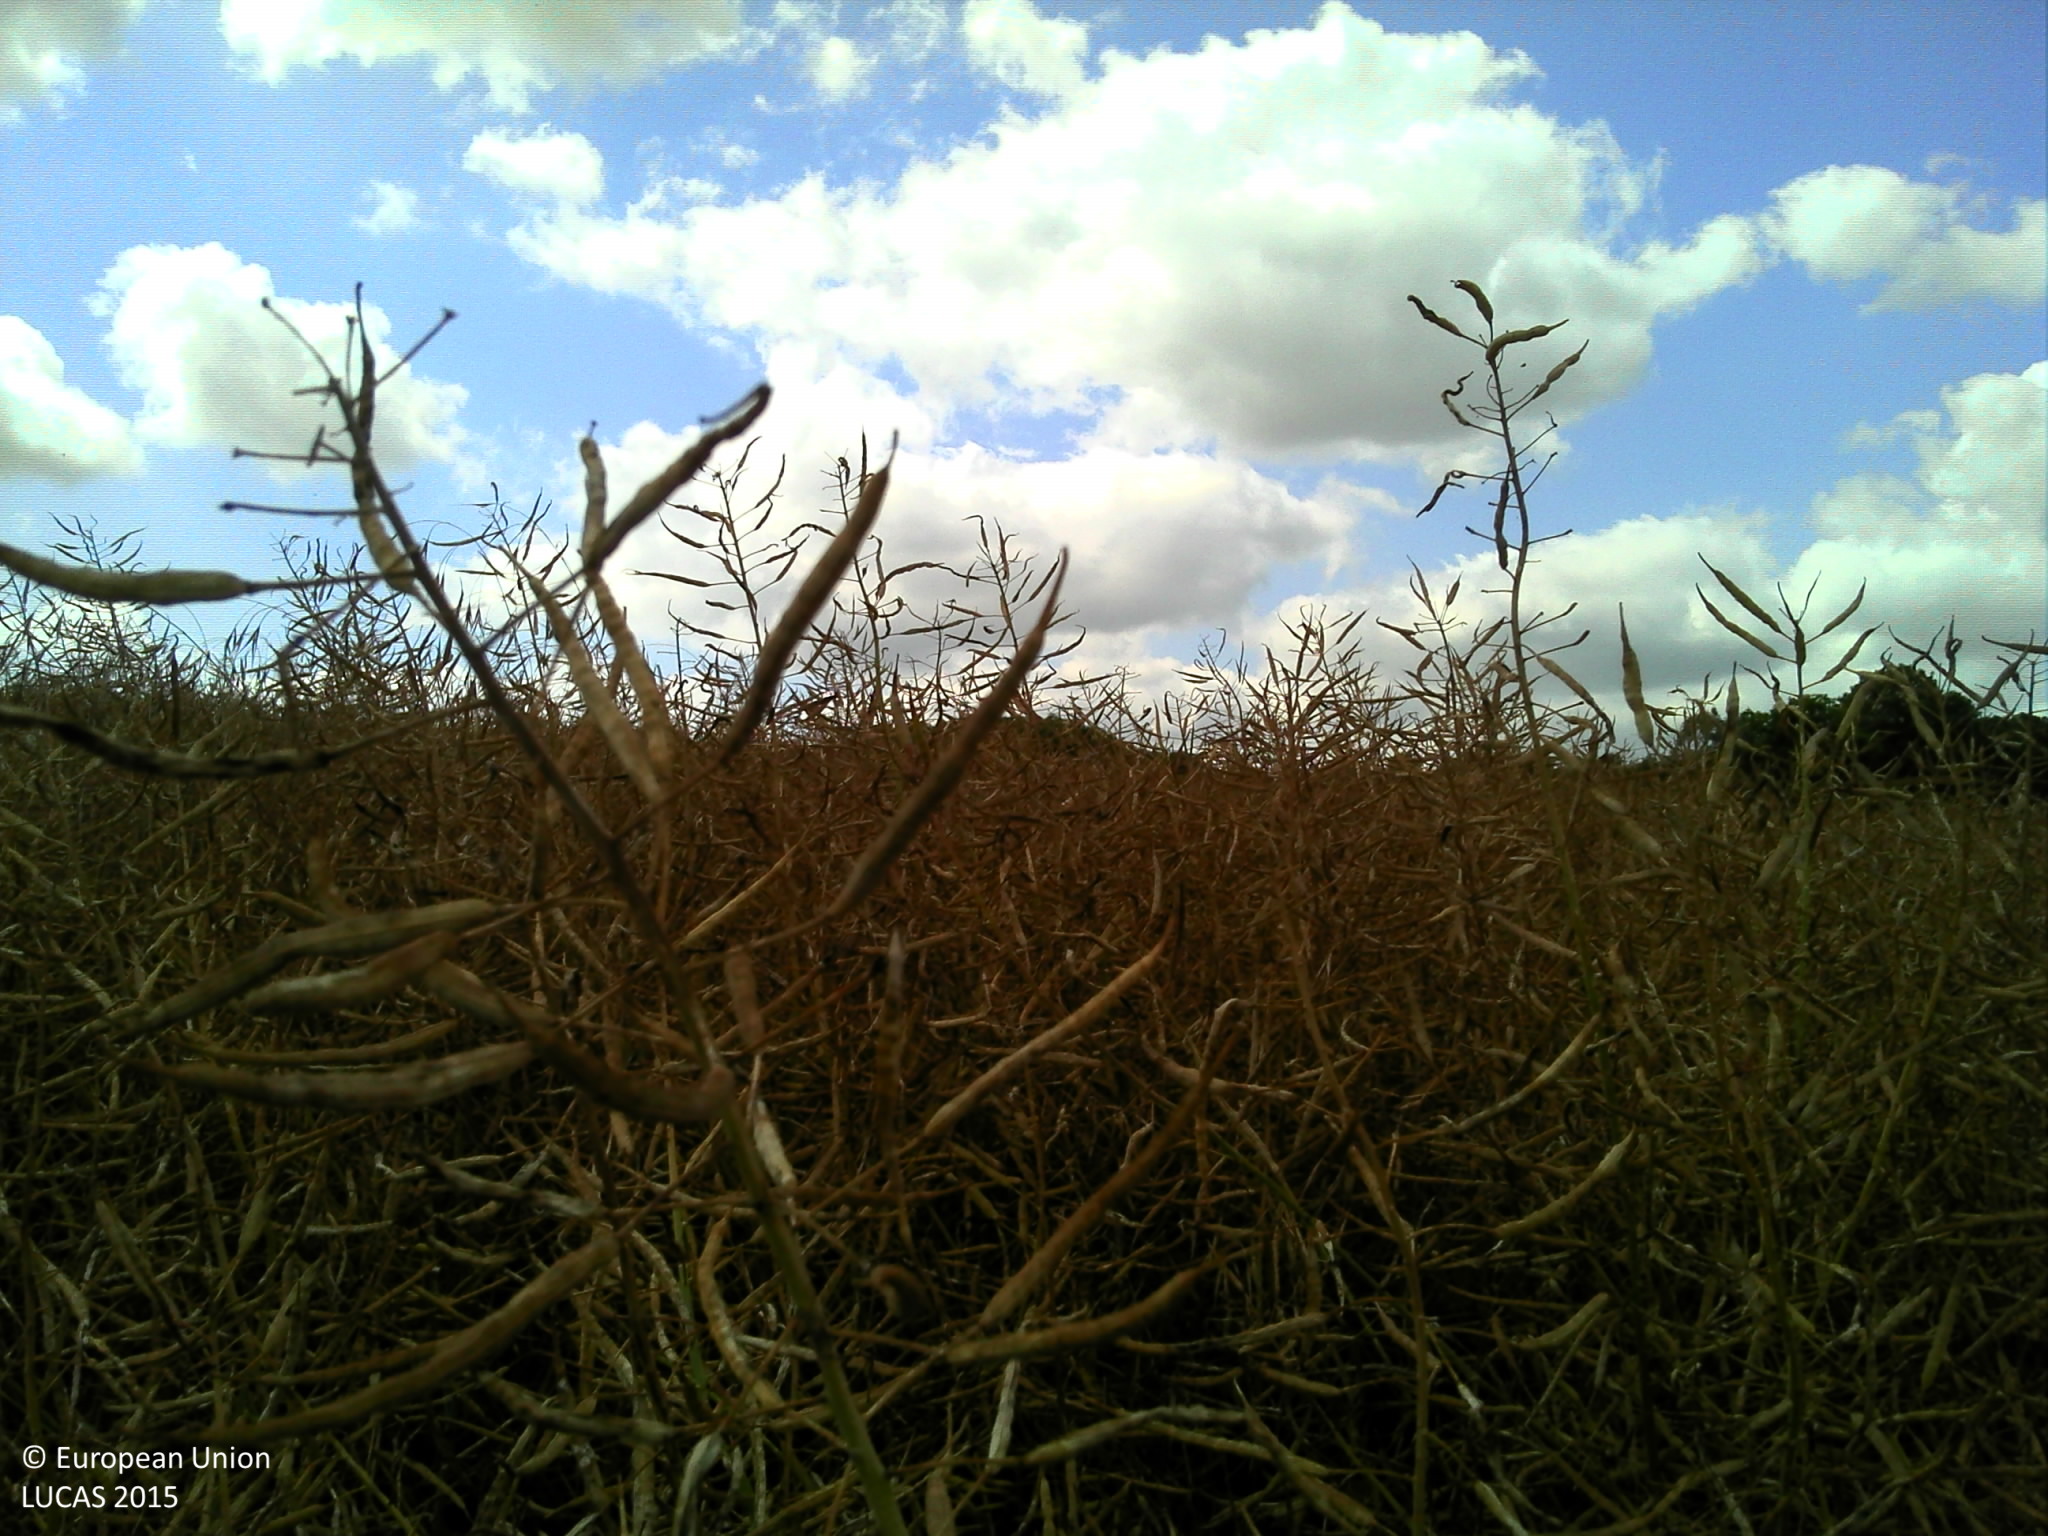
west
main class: Cropland
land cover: Rape and turnip rape
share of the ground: > 75 %
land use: Agriculture (excluding fallow land and kitchen gardens)
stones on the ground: < 10 %
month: July
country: FR
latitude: 48.9812
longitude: -0.2123
